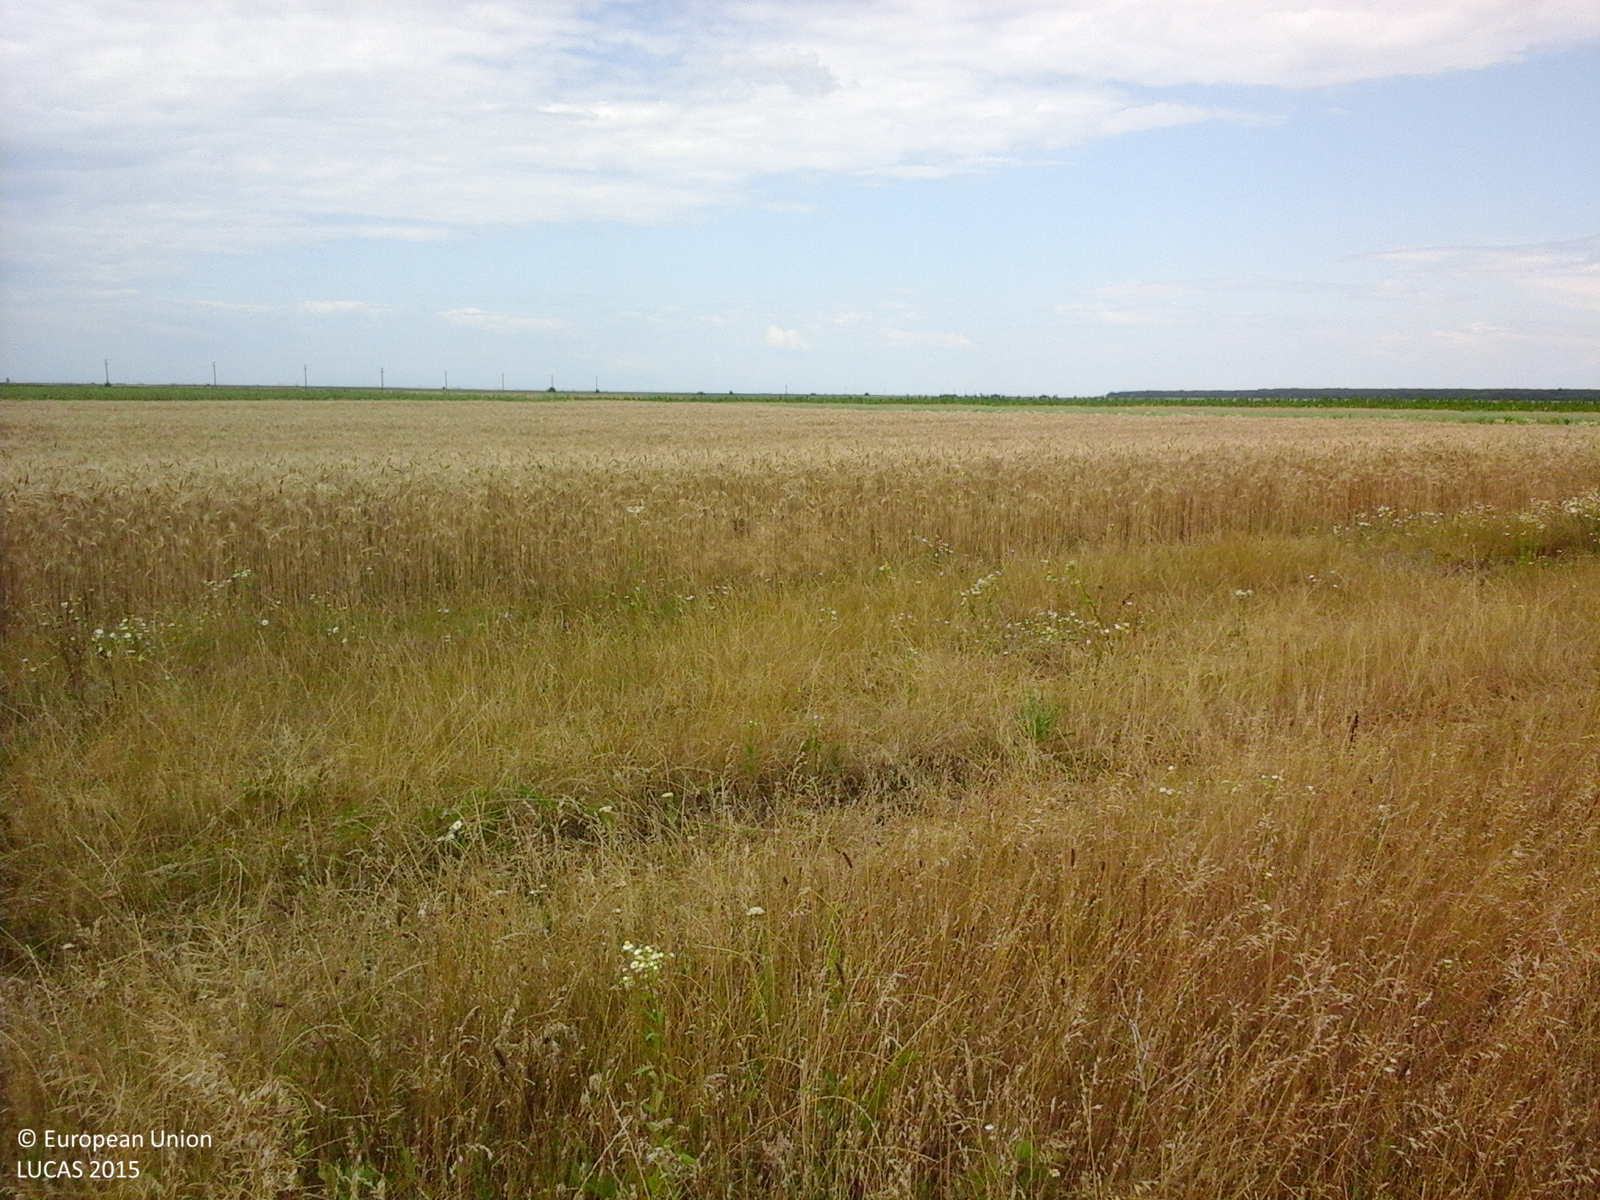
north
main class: Grassland
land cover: Spontaneously vegetated surfaces
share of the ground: > 75 %
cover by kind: herbaceous plants 100 %
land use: Agriculture (excluding fallow land and kitchen gardens)
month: July
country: RO
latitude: 44.3610
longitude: 25.4342
